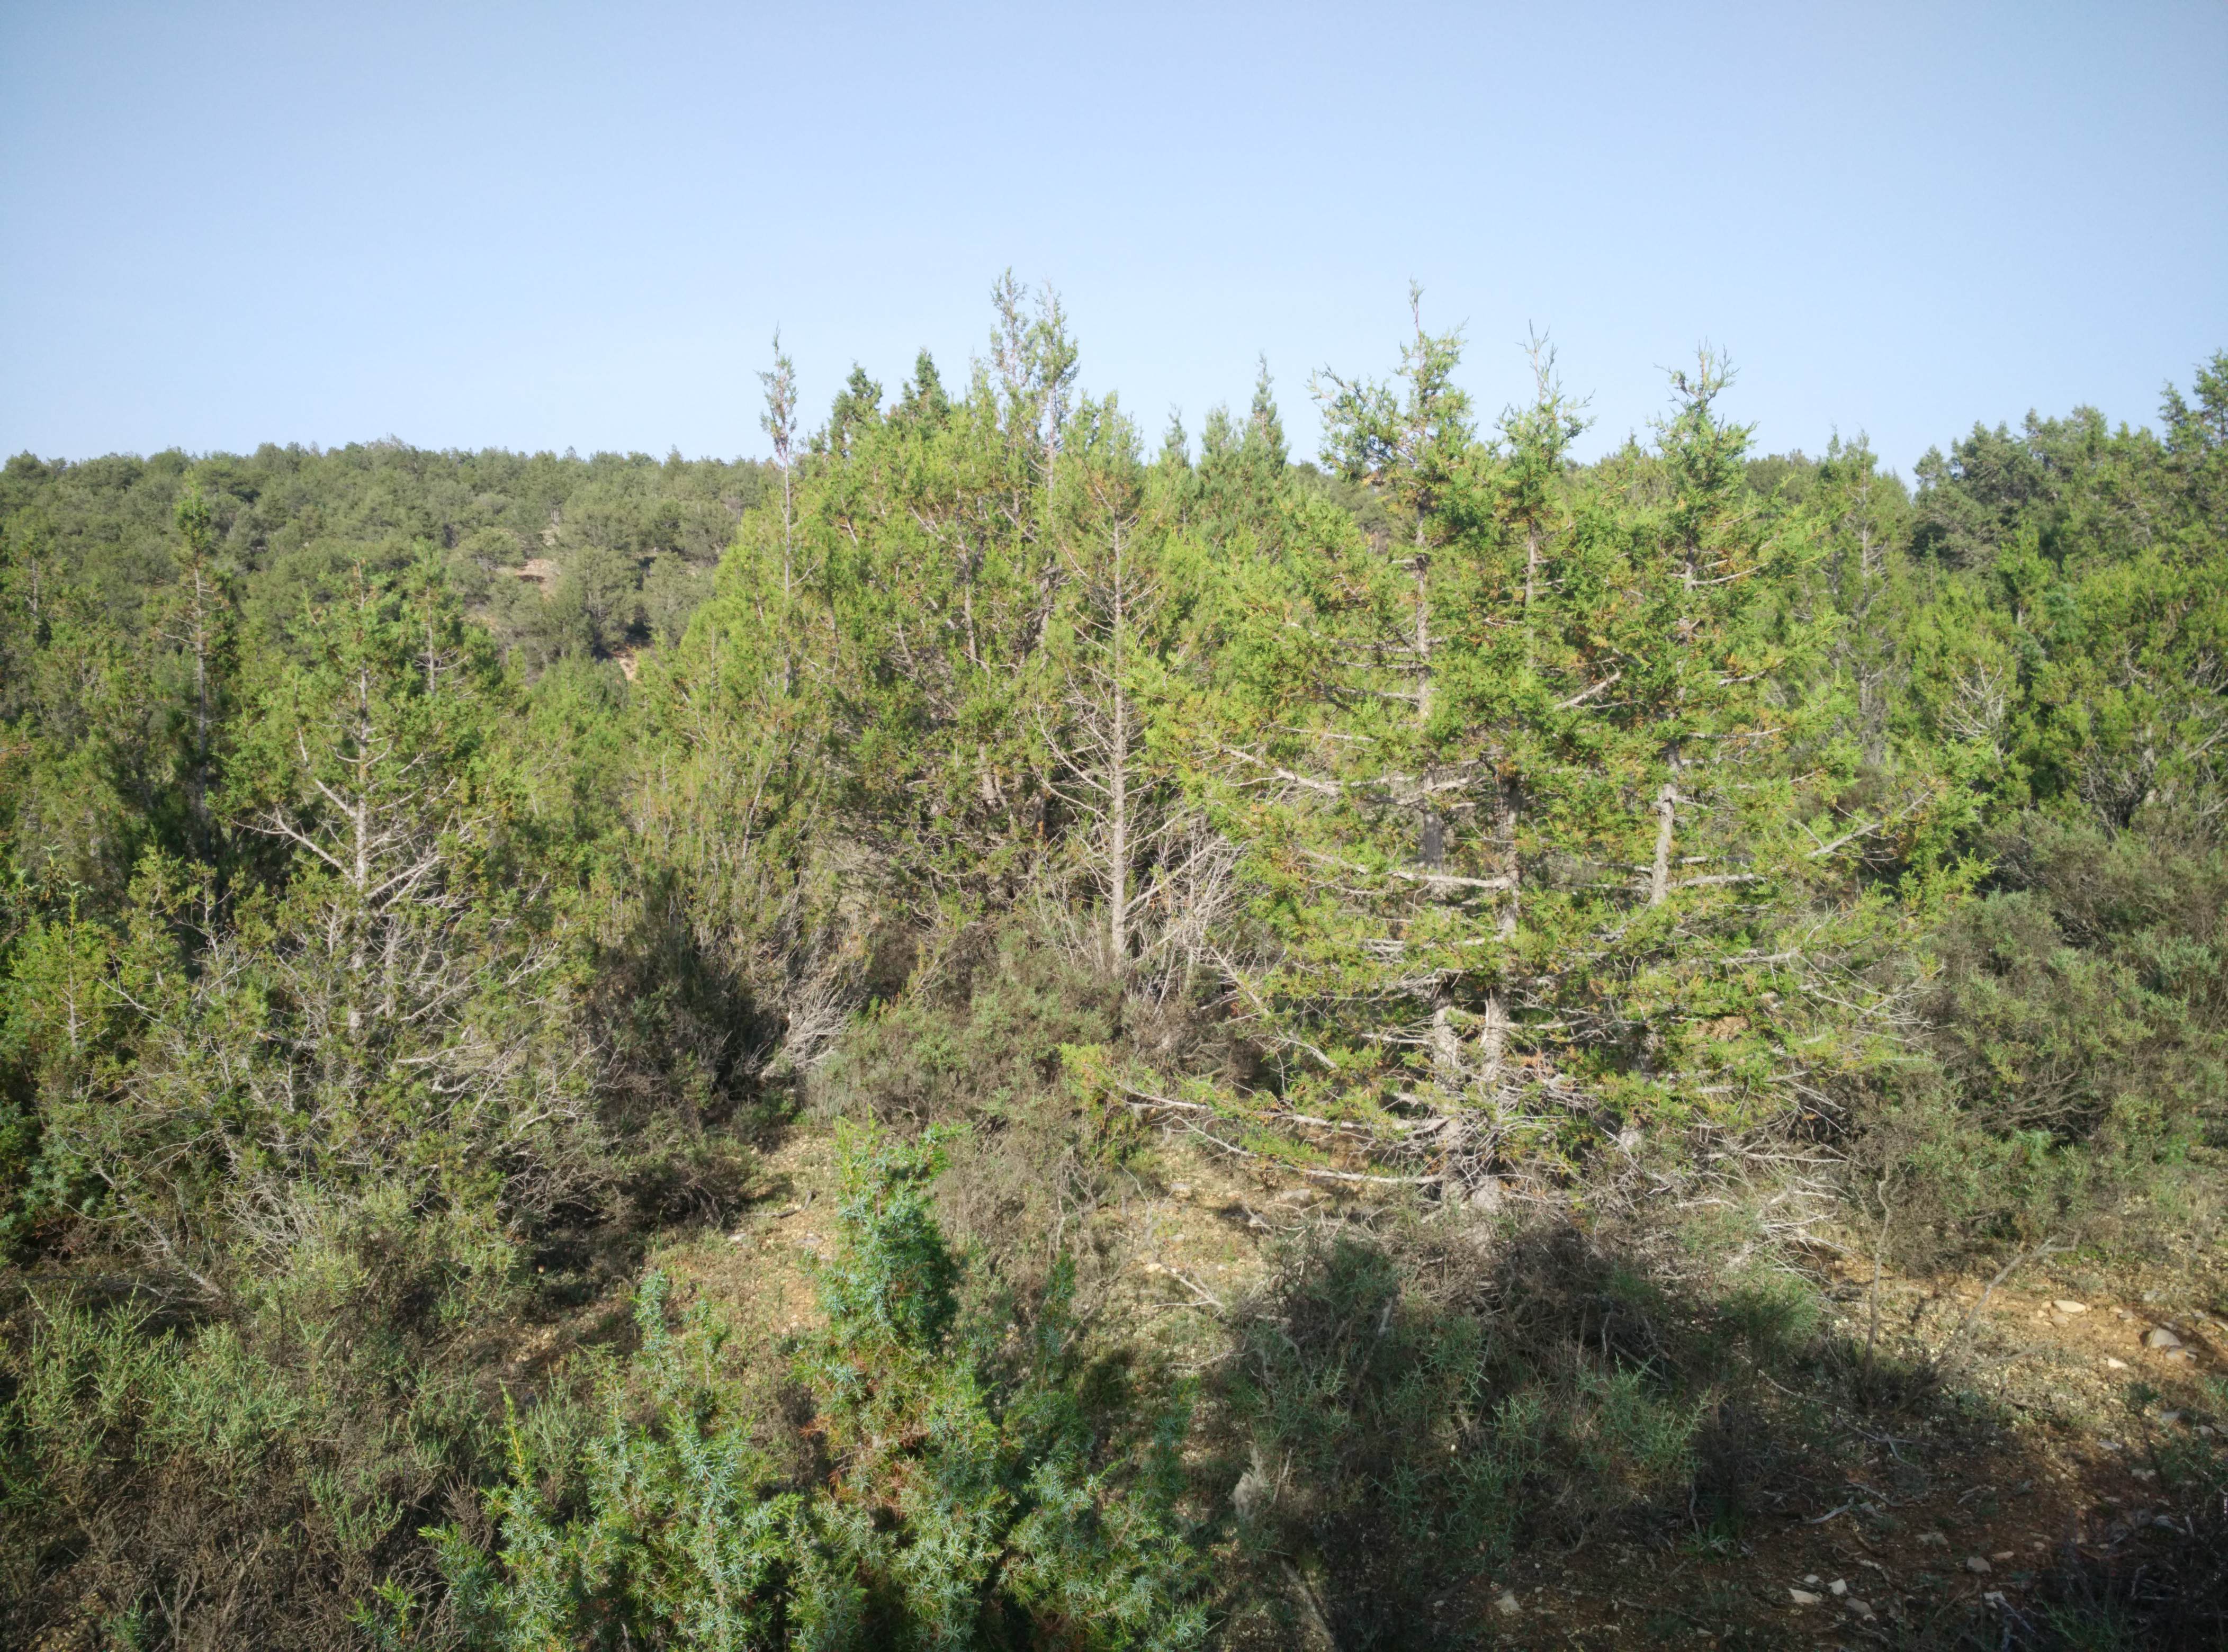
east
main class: Woodland
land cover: Other coniferous woodland
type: coniferous forest of the mediterranean region
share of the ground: 25 - 50 %
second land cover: Shrubland without tree cover
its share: 50 - 75 %
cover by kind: shrubs 50 %, coniferous forest trees 25 %, unconsolidated bare surface 25 %
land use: Forestry
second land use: Agriculture (excluding fallow land and kitchen gardens)
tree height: > 5 m
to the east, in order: Other coniferous woodland; Shrubland without tree cover; Tracks; Other coniferous woodland; Rock outcrops; Other coniferous woodland
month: July
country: ES
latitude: 40.9719
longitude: -1.9912
